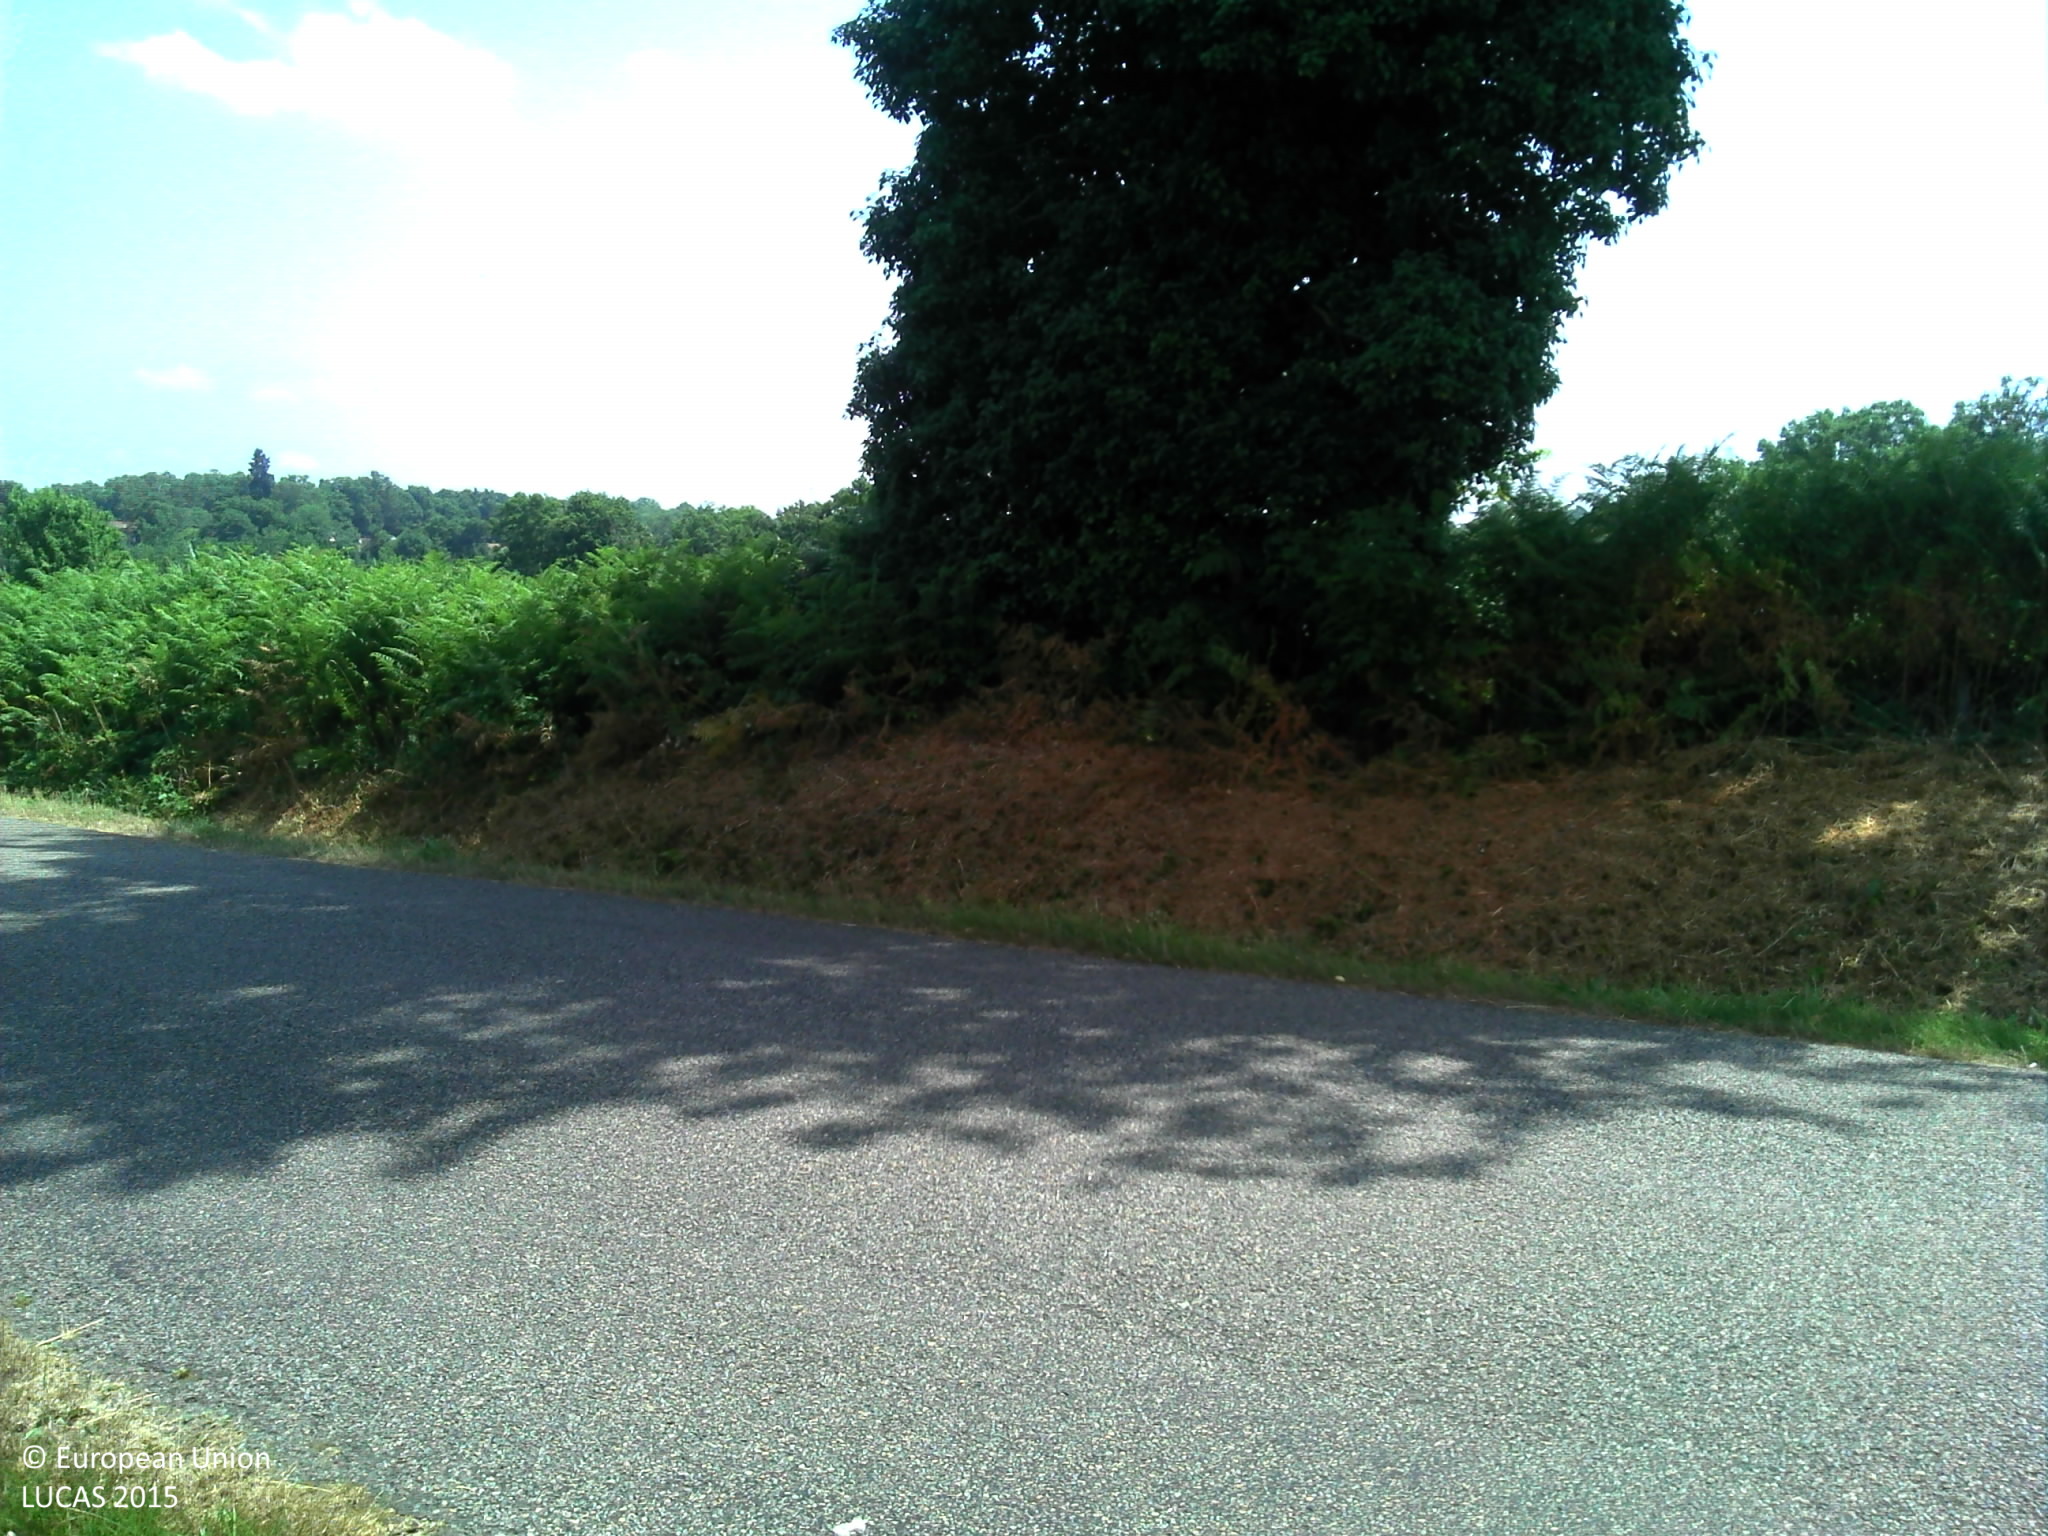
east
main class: Grassland
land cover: Grassland without tree/shrub cover
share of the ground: > 75 %
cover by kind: herbaceous plants 95 %
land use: Agriculture (excluding fallow land and kitchen gardens)
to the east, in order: Grassland without tree/shrub cover; Fences; Lines of trees; Grass margins; Paved roads, cycling and walking lanes; Grass margins; Ditches and canals; Abandoned hedges; Fences; Maize
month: July
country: FR
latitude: 45.7340
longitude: 0.9809
